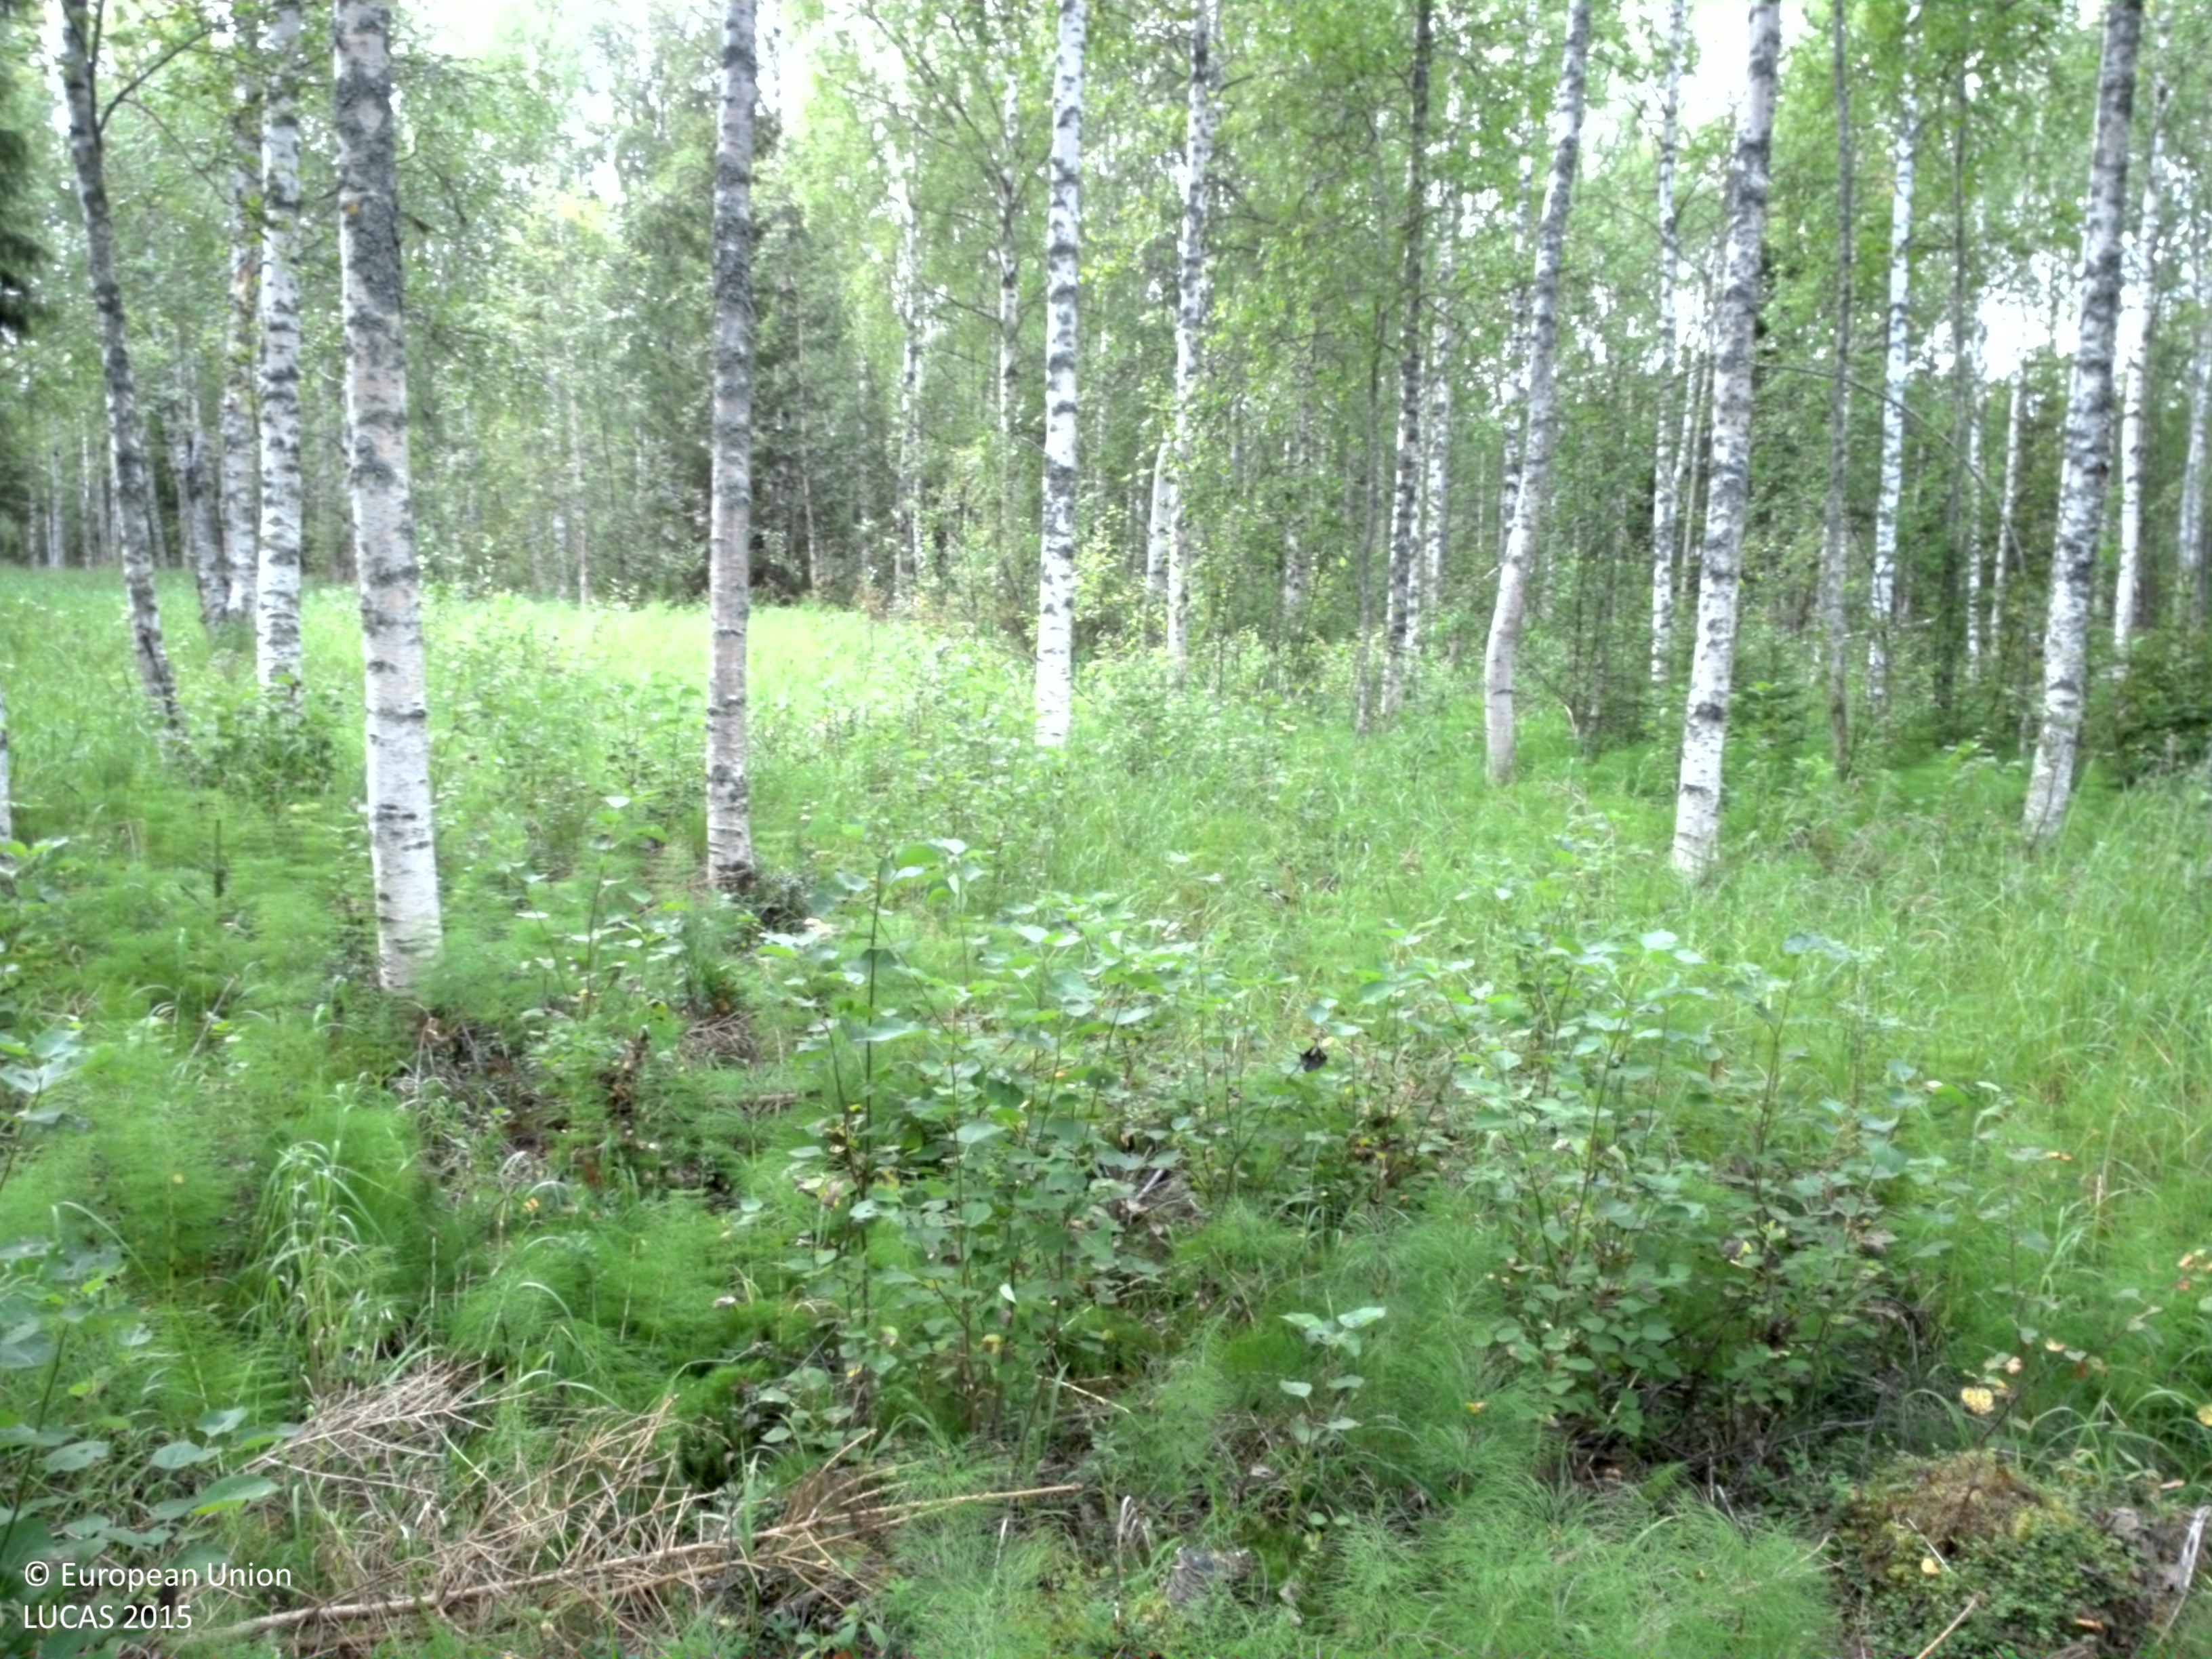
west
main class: Woodland
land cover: Broadleaved woodland
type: non-riverine alder, birch or aspen forest
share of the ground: 25 - 50 %
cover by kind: shrubs 50 %, broadleaved forest trees 40 %, coniferous forest trees 5 %, lichens and mosses 5 %
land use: Forestry
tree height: > 5 m
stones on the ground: < 10 %
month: August
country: SE
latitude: 65.8911
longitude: 22.6405
